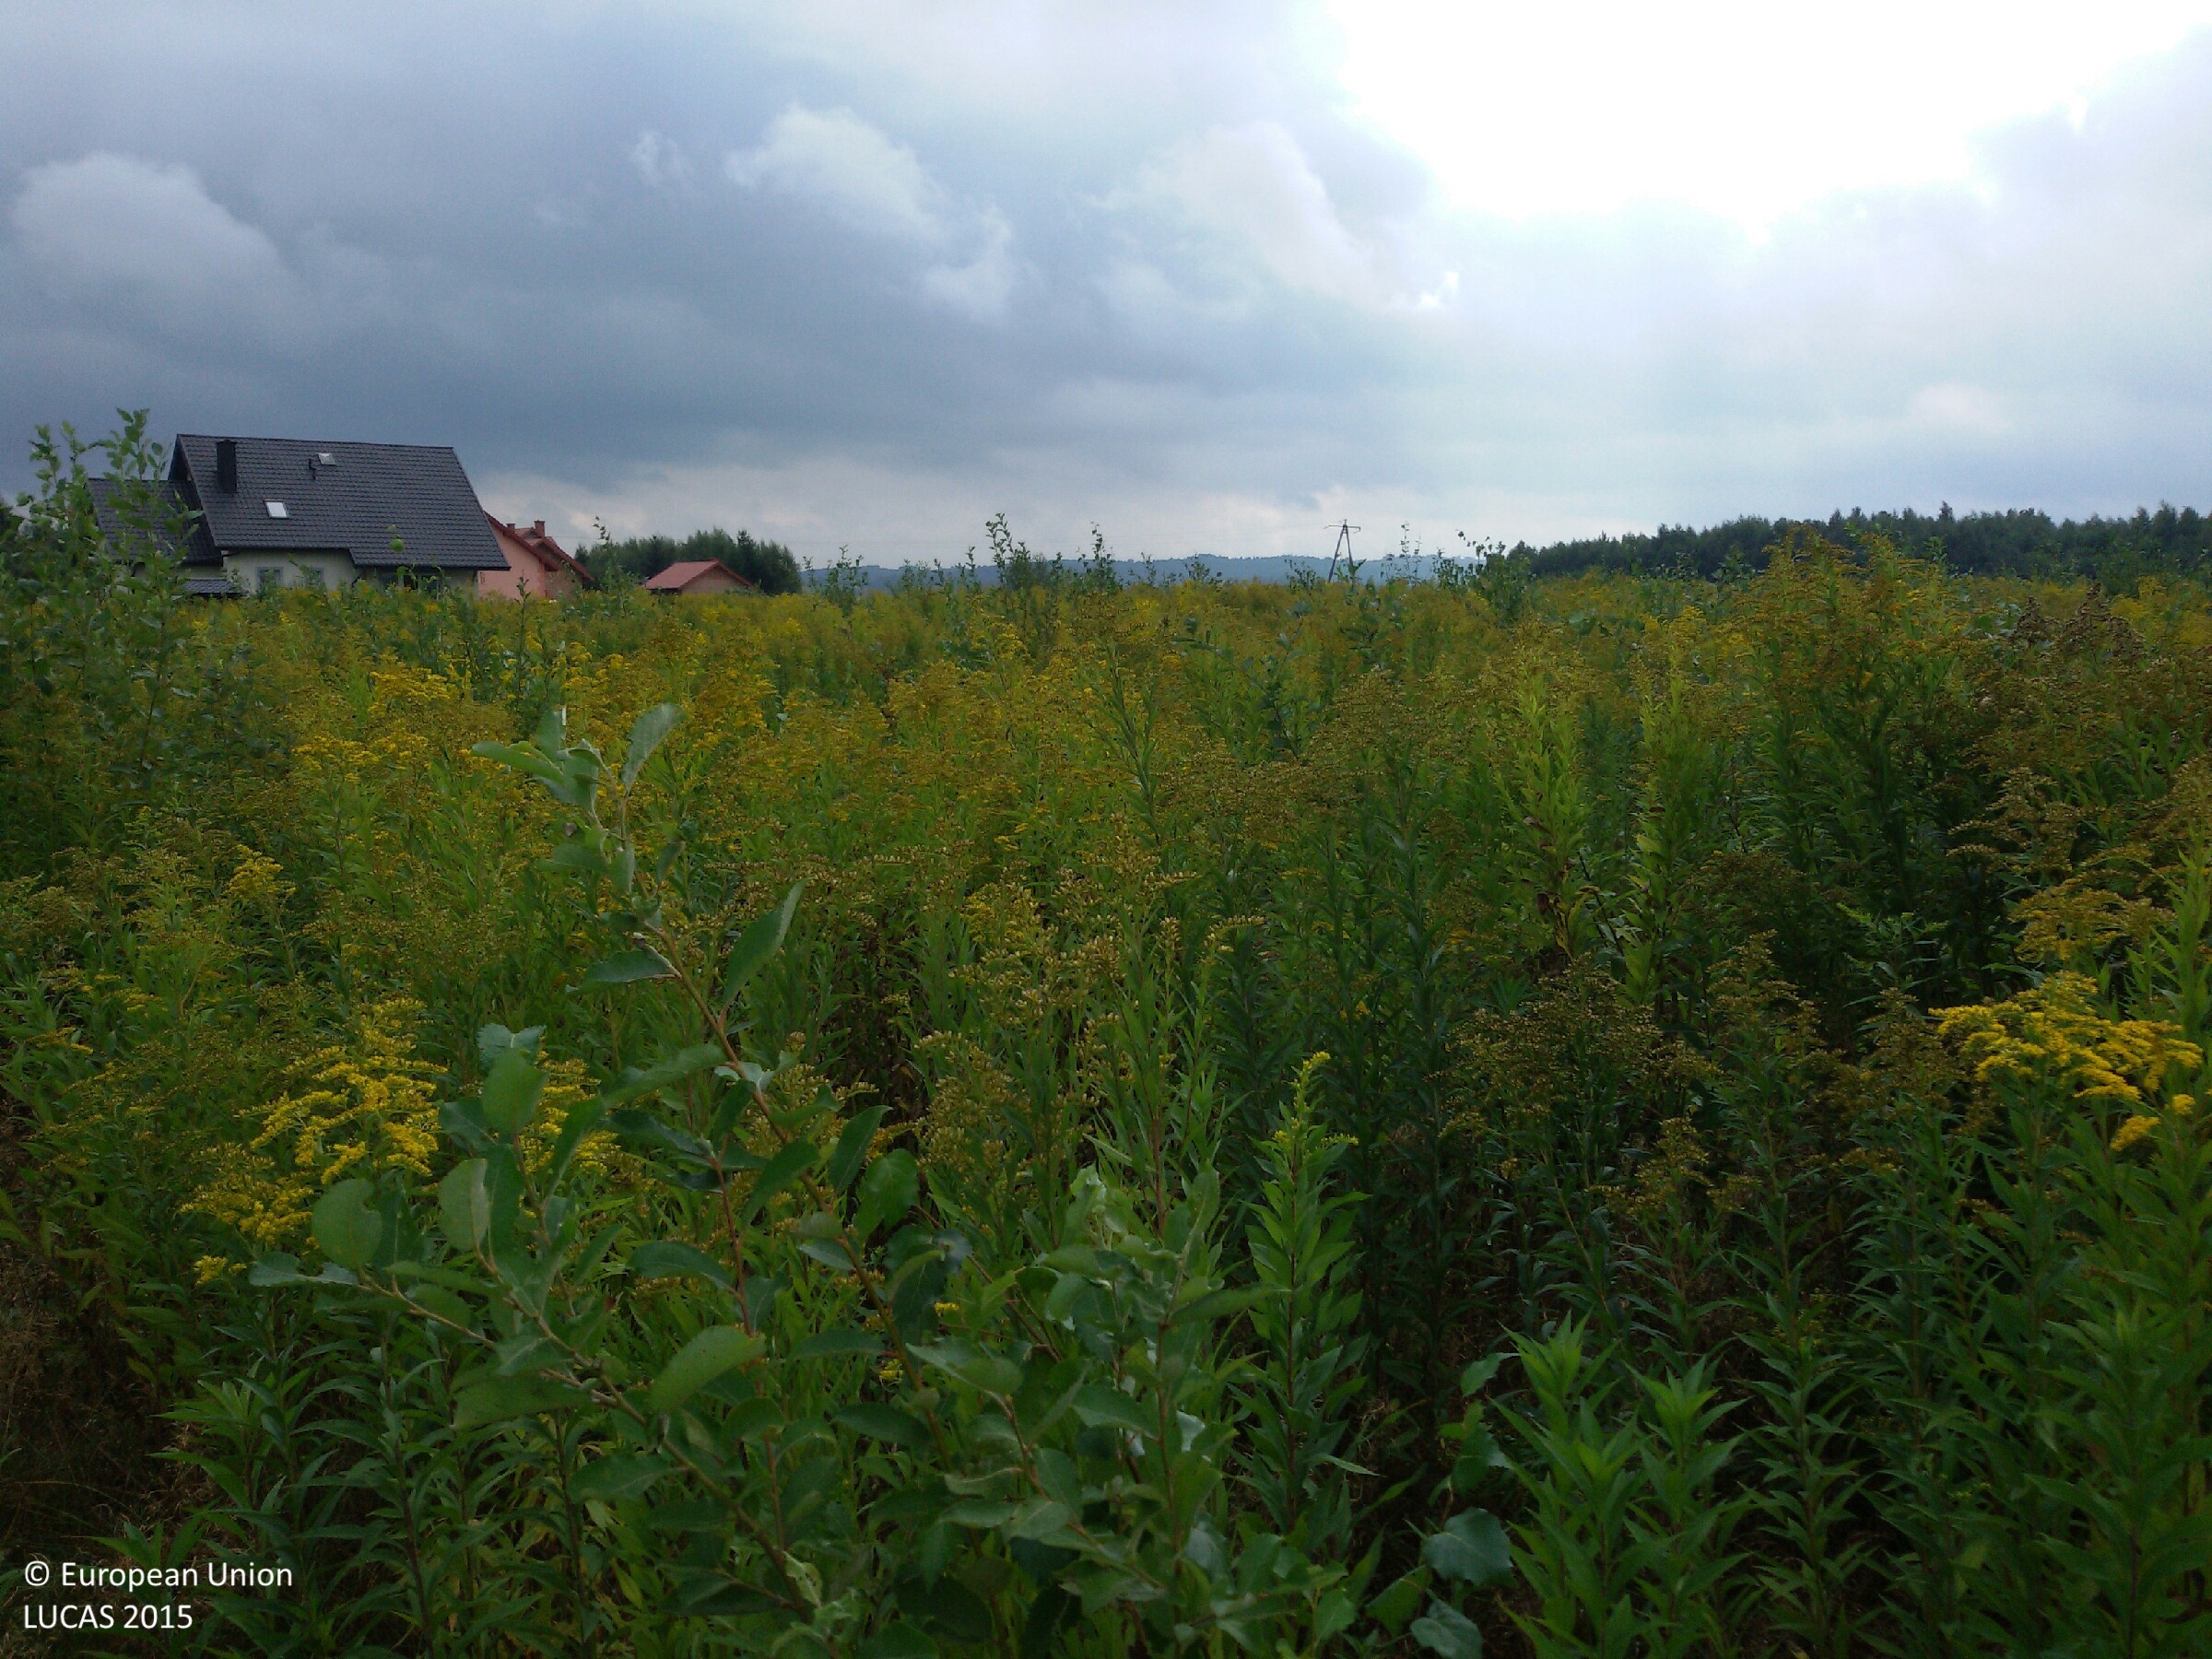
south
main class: Grassland
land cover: Spontaneously vegetated surfaces
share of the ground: > 75 %
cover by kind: herbaceous plants 100 %
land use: Fallow land
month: September
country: PL
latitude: 49.9862
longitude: 21.2745
